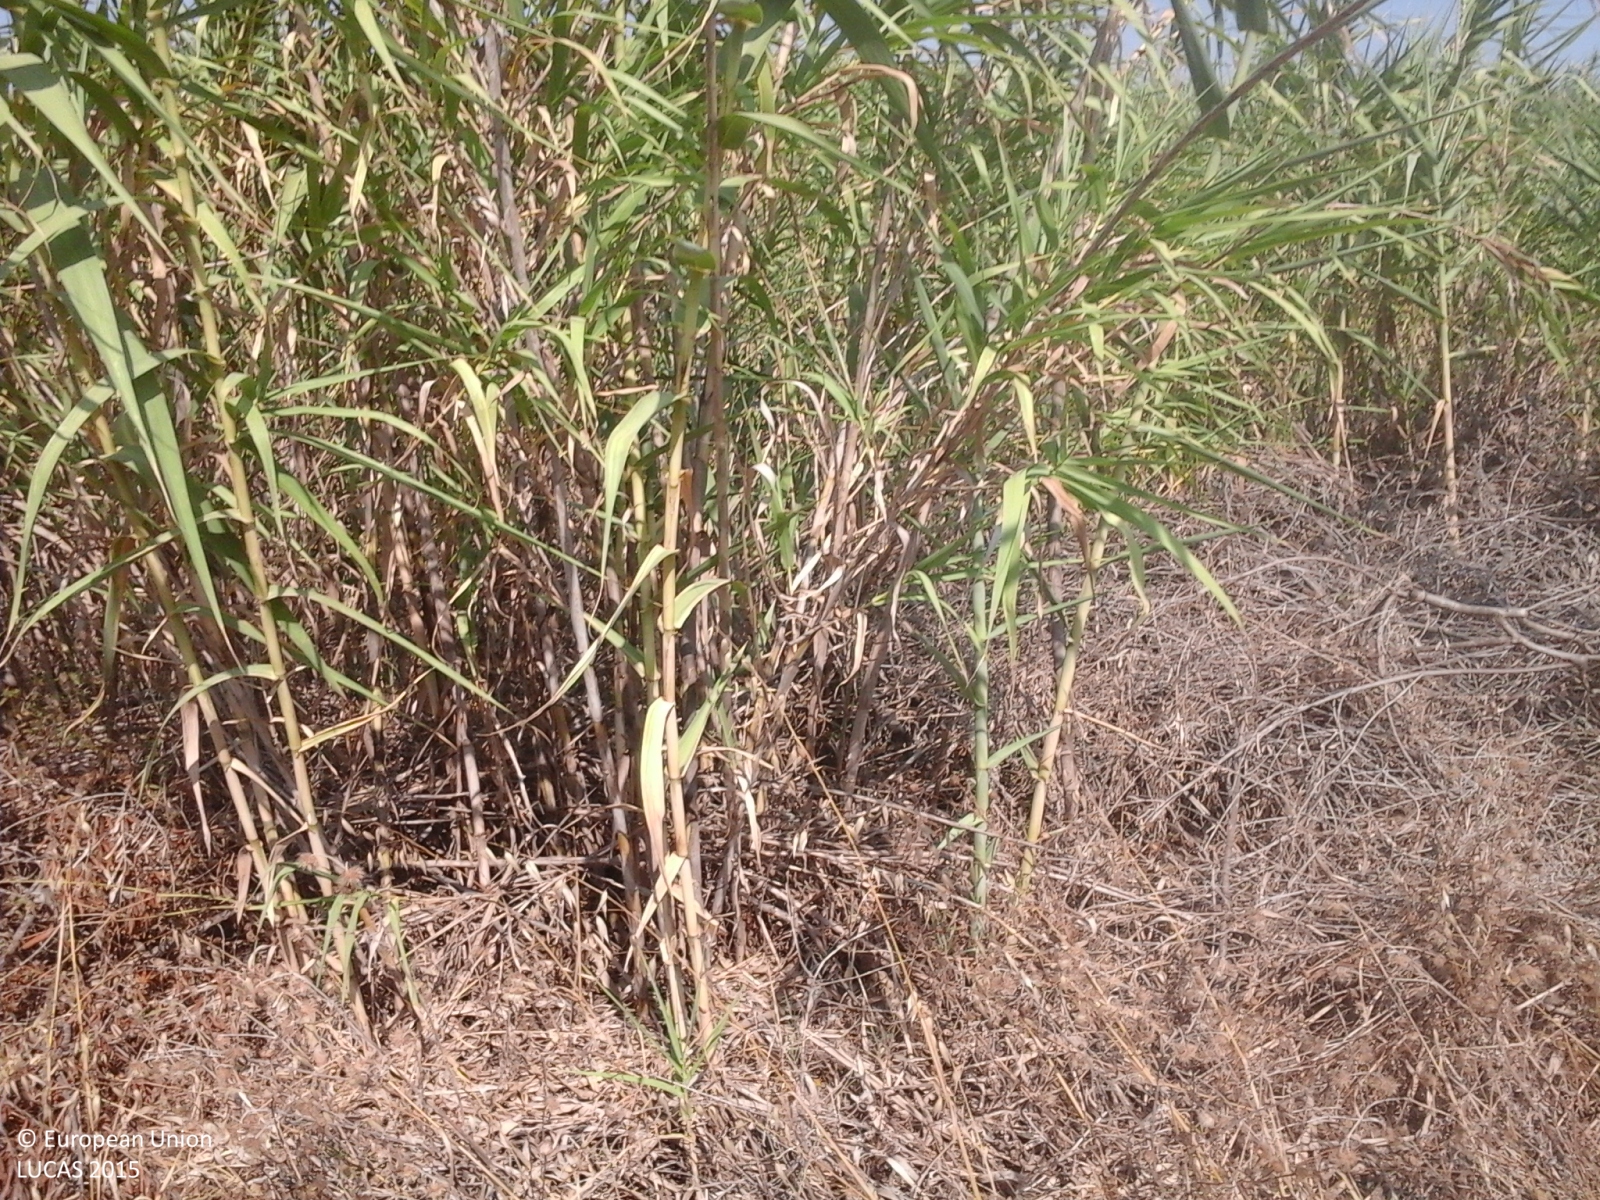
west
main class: Grassland
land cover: Grassland with sparse tree/shrub cover
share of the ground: > 75 %
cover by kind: herbaceous plants 95 %, broadleaved forest trees 5 %
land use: Agriculture (excluding fallow land and kitchen gardens)
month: July
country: IT
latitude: 37.0474
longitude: 14.3619
